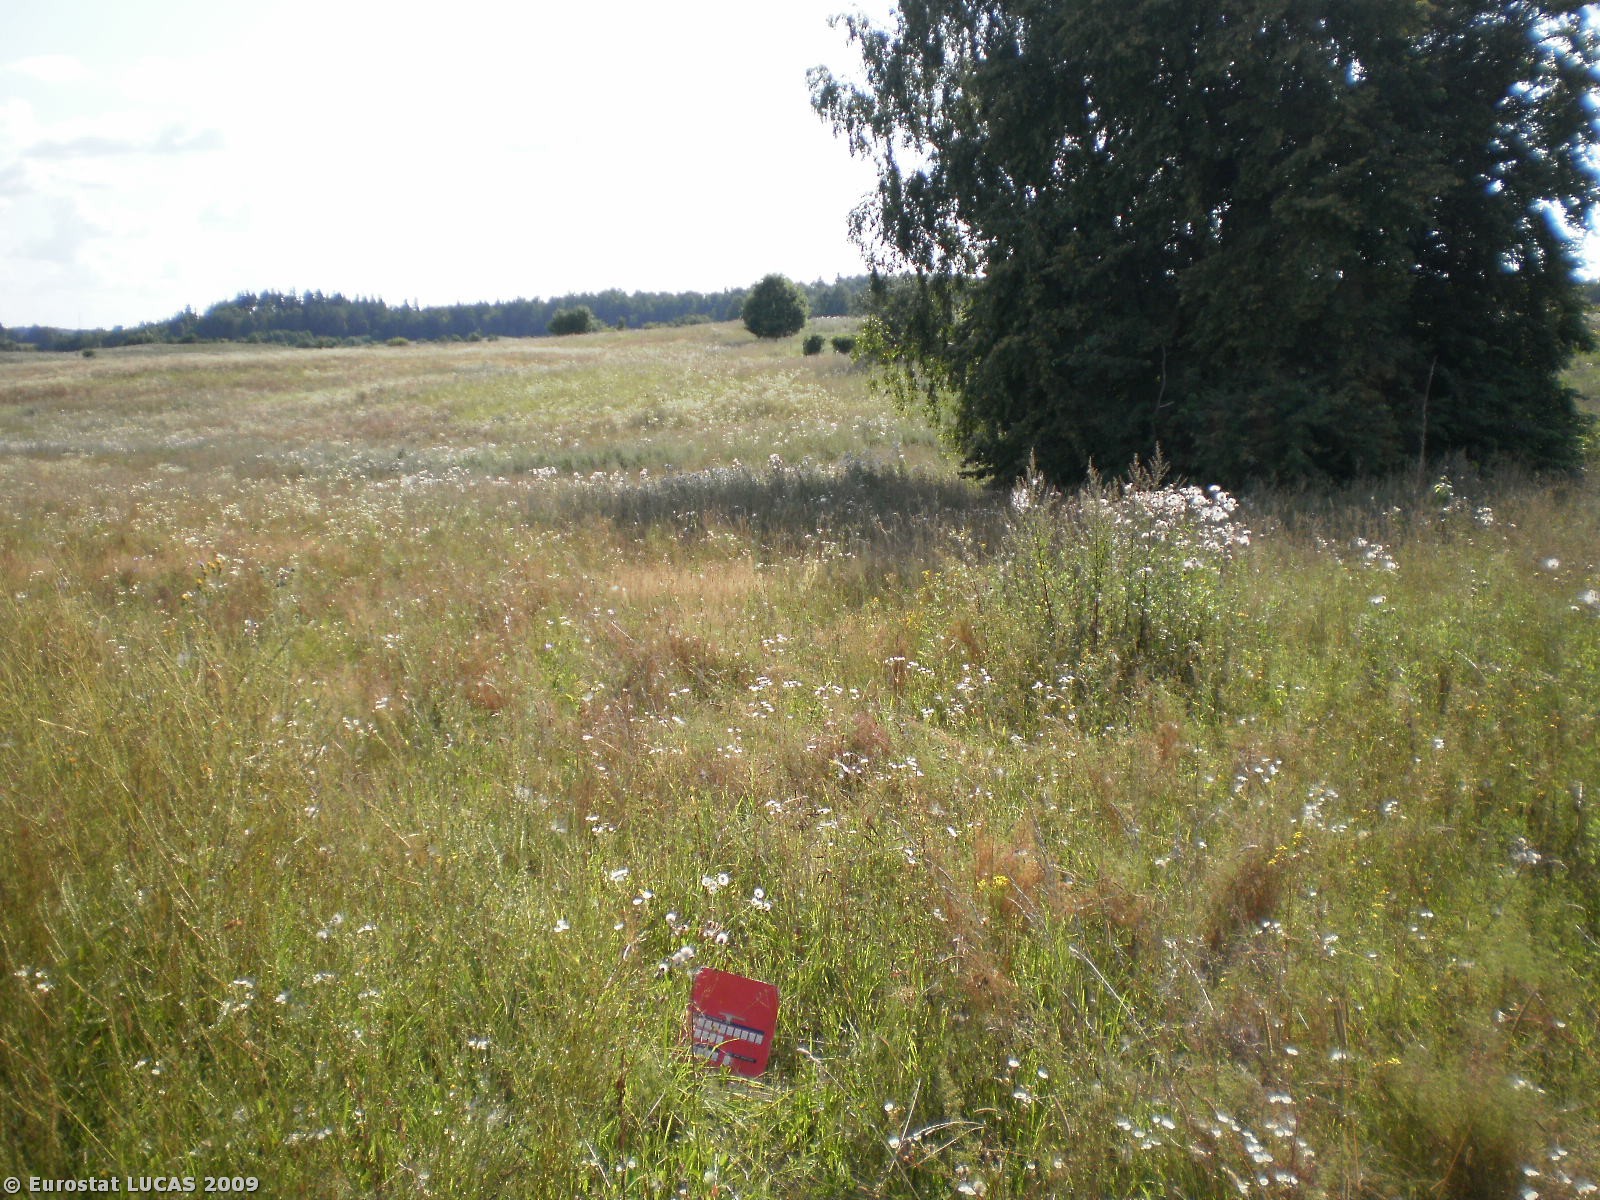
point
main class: Grassland
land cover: Grassland without tree/shrub cover
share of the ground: > 75 %
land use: Fallow land
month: August
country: PL
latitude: 53.8852
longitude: 21.1354
